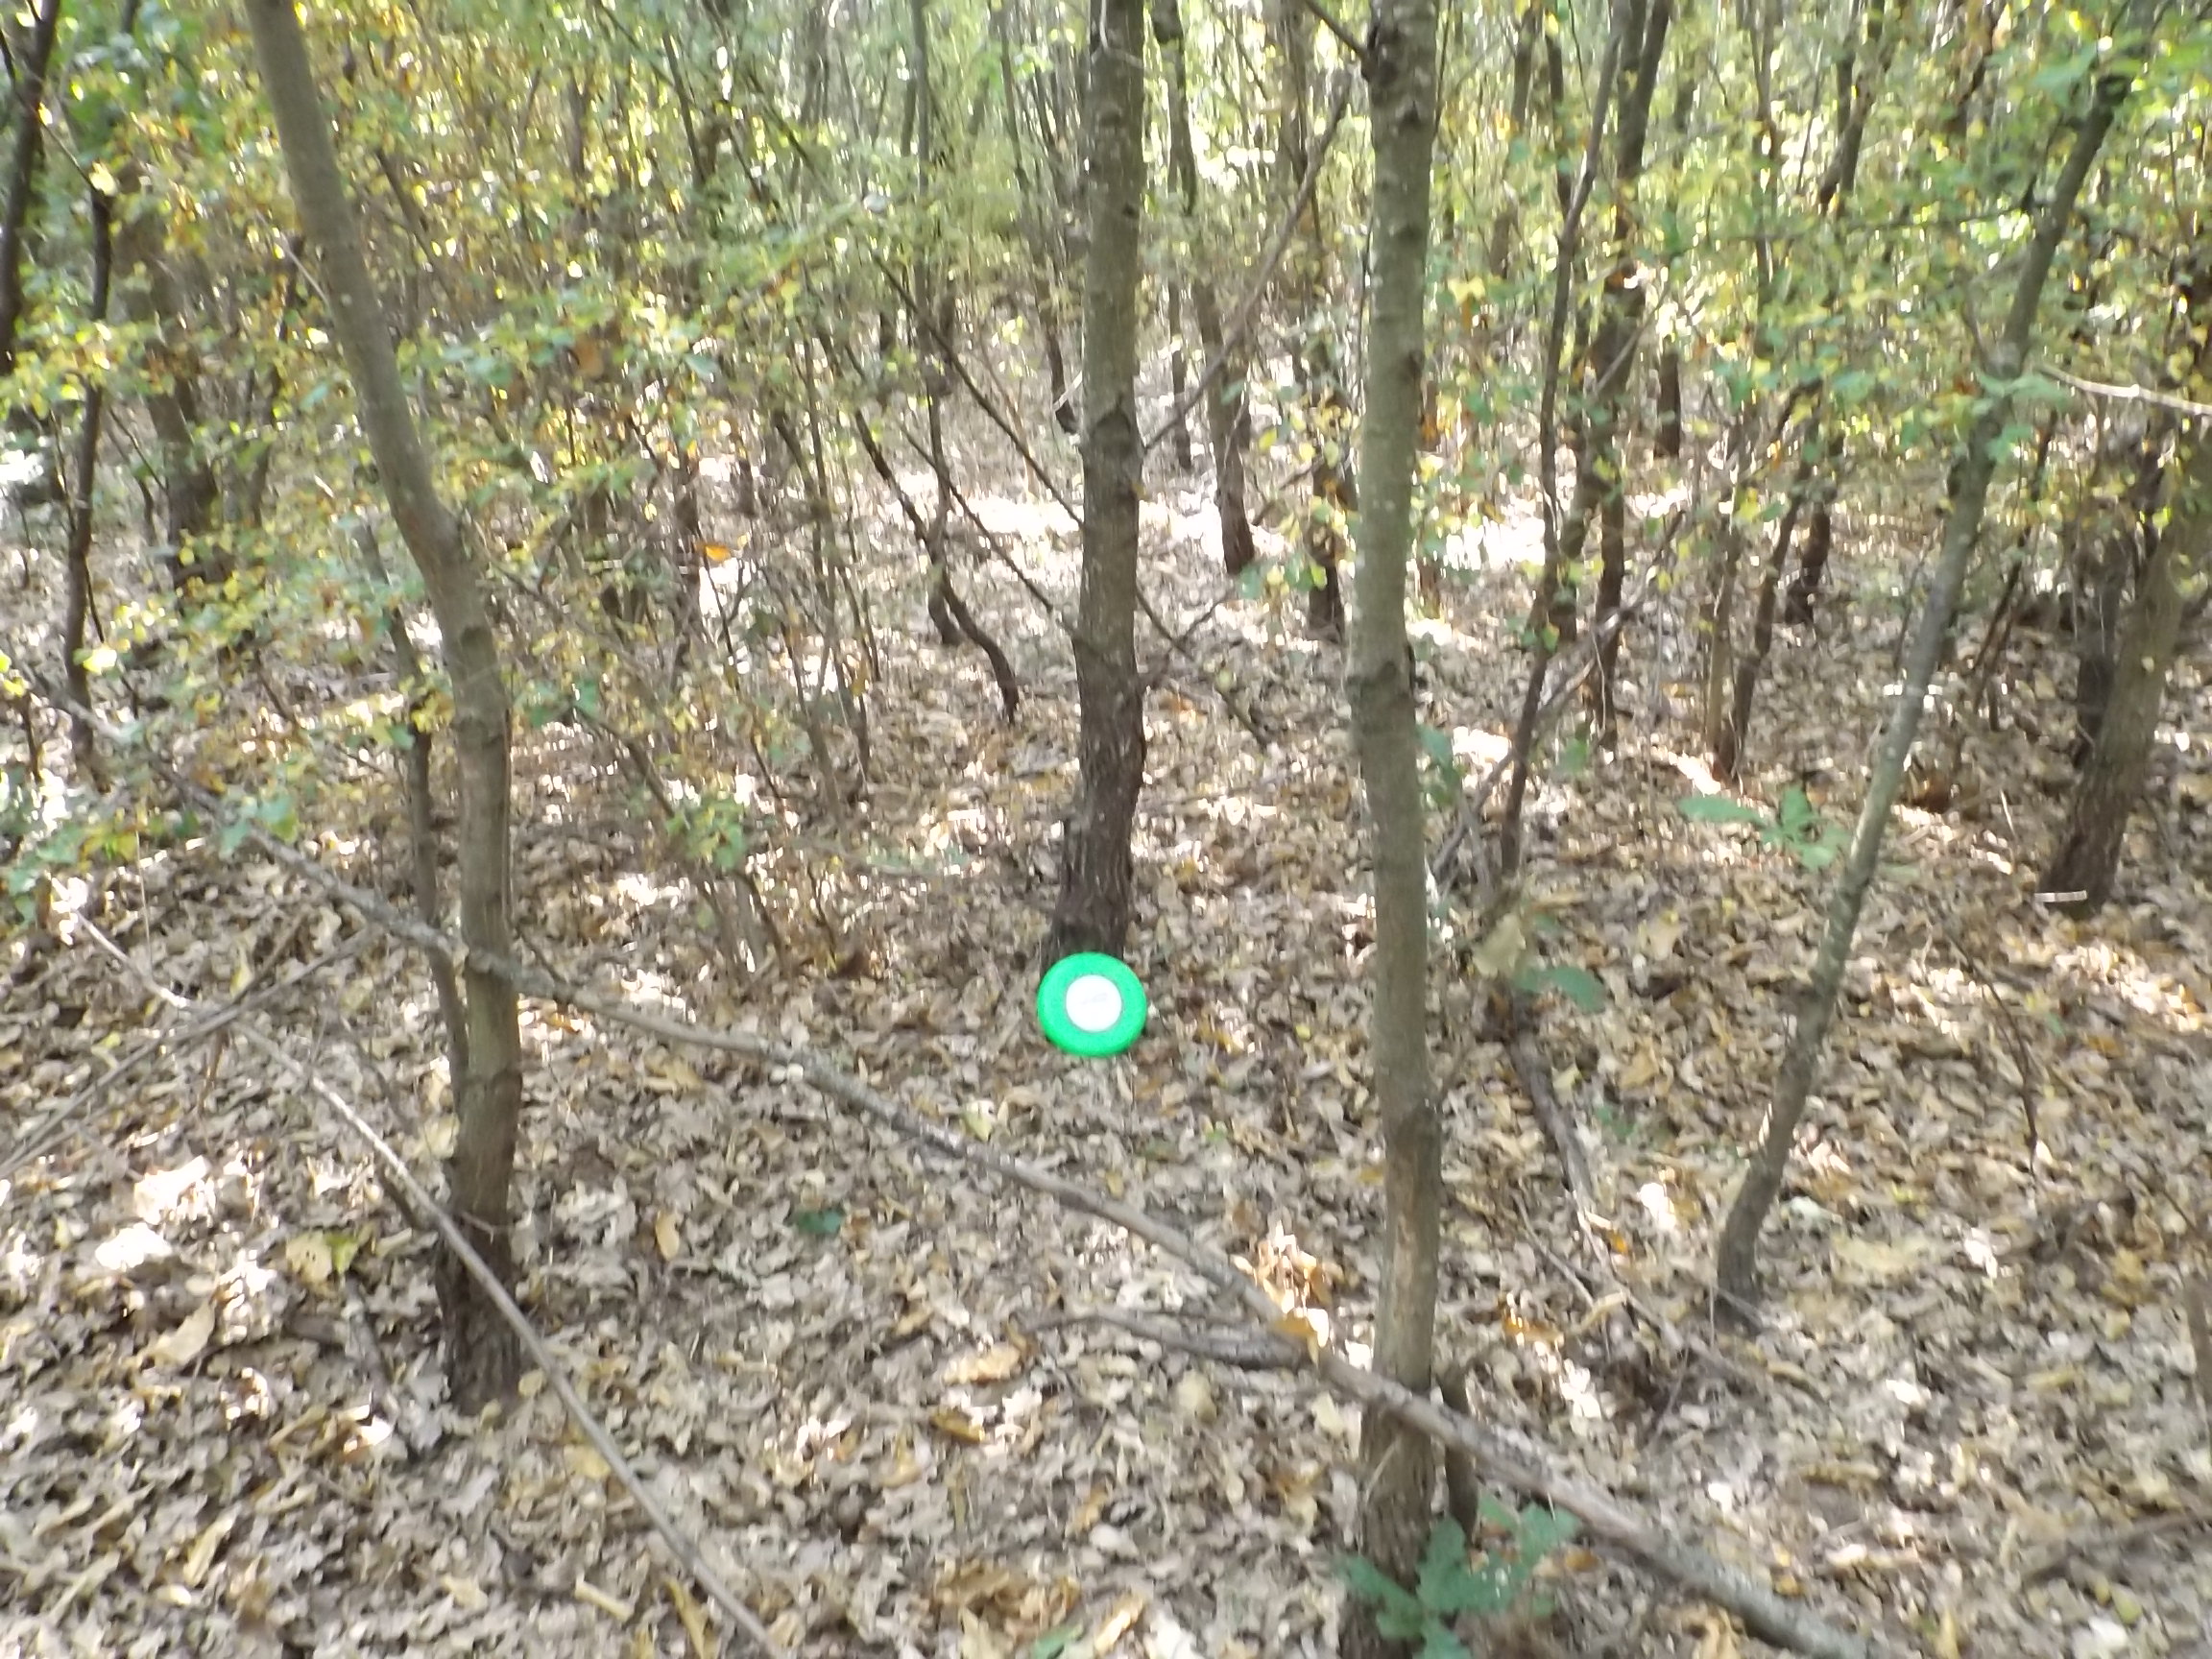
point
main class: Woodland
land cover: Broadleaved woodland
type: mesophytic deciduous forest
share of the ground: > 75 %
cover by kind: broadleaved forest trees 95 %, herbaceous plants 5 %
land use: Forestry
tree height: > 5 m
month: July
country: BG
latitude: 43.4790
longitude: 27.3739
